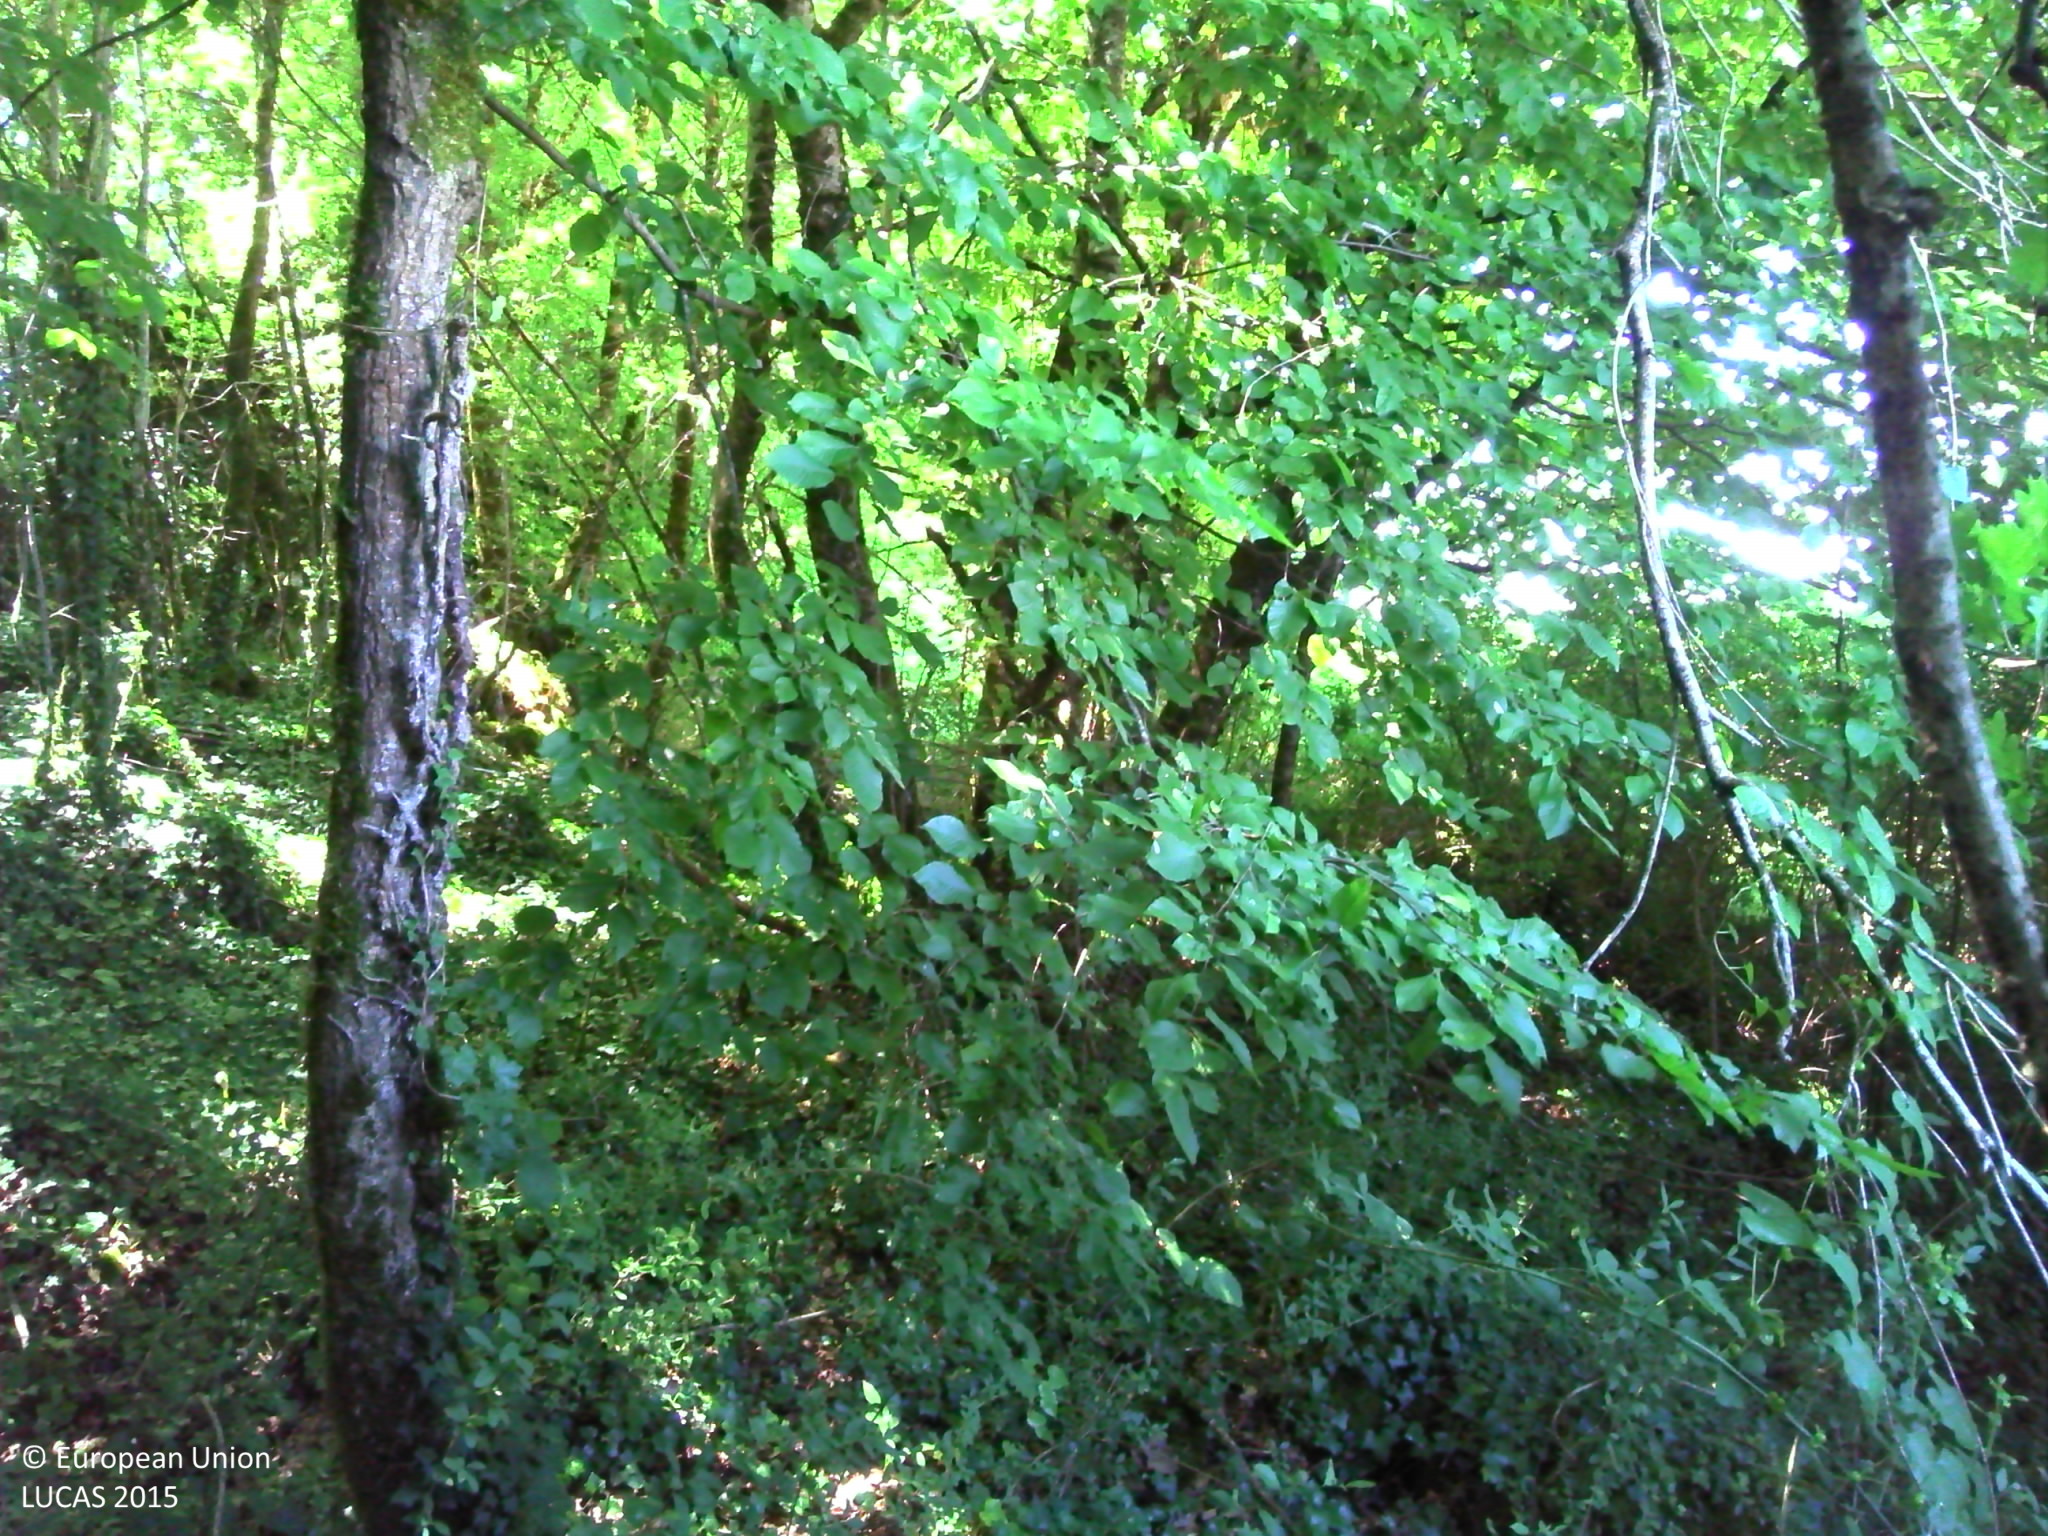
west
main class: Woodland
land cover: Broadleaved woodland
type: boreal forest
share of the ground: > 75 %
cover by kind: broadleaved forest trees 90 %, herbaceous plants 10 %
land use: Semi-natural and natural areas not in use
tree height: > 5 m
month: June
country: FR
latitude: 45.6132
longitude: 0.4326
